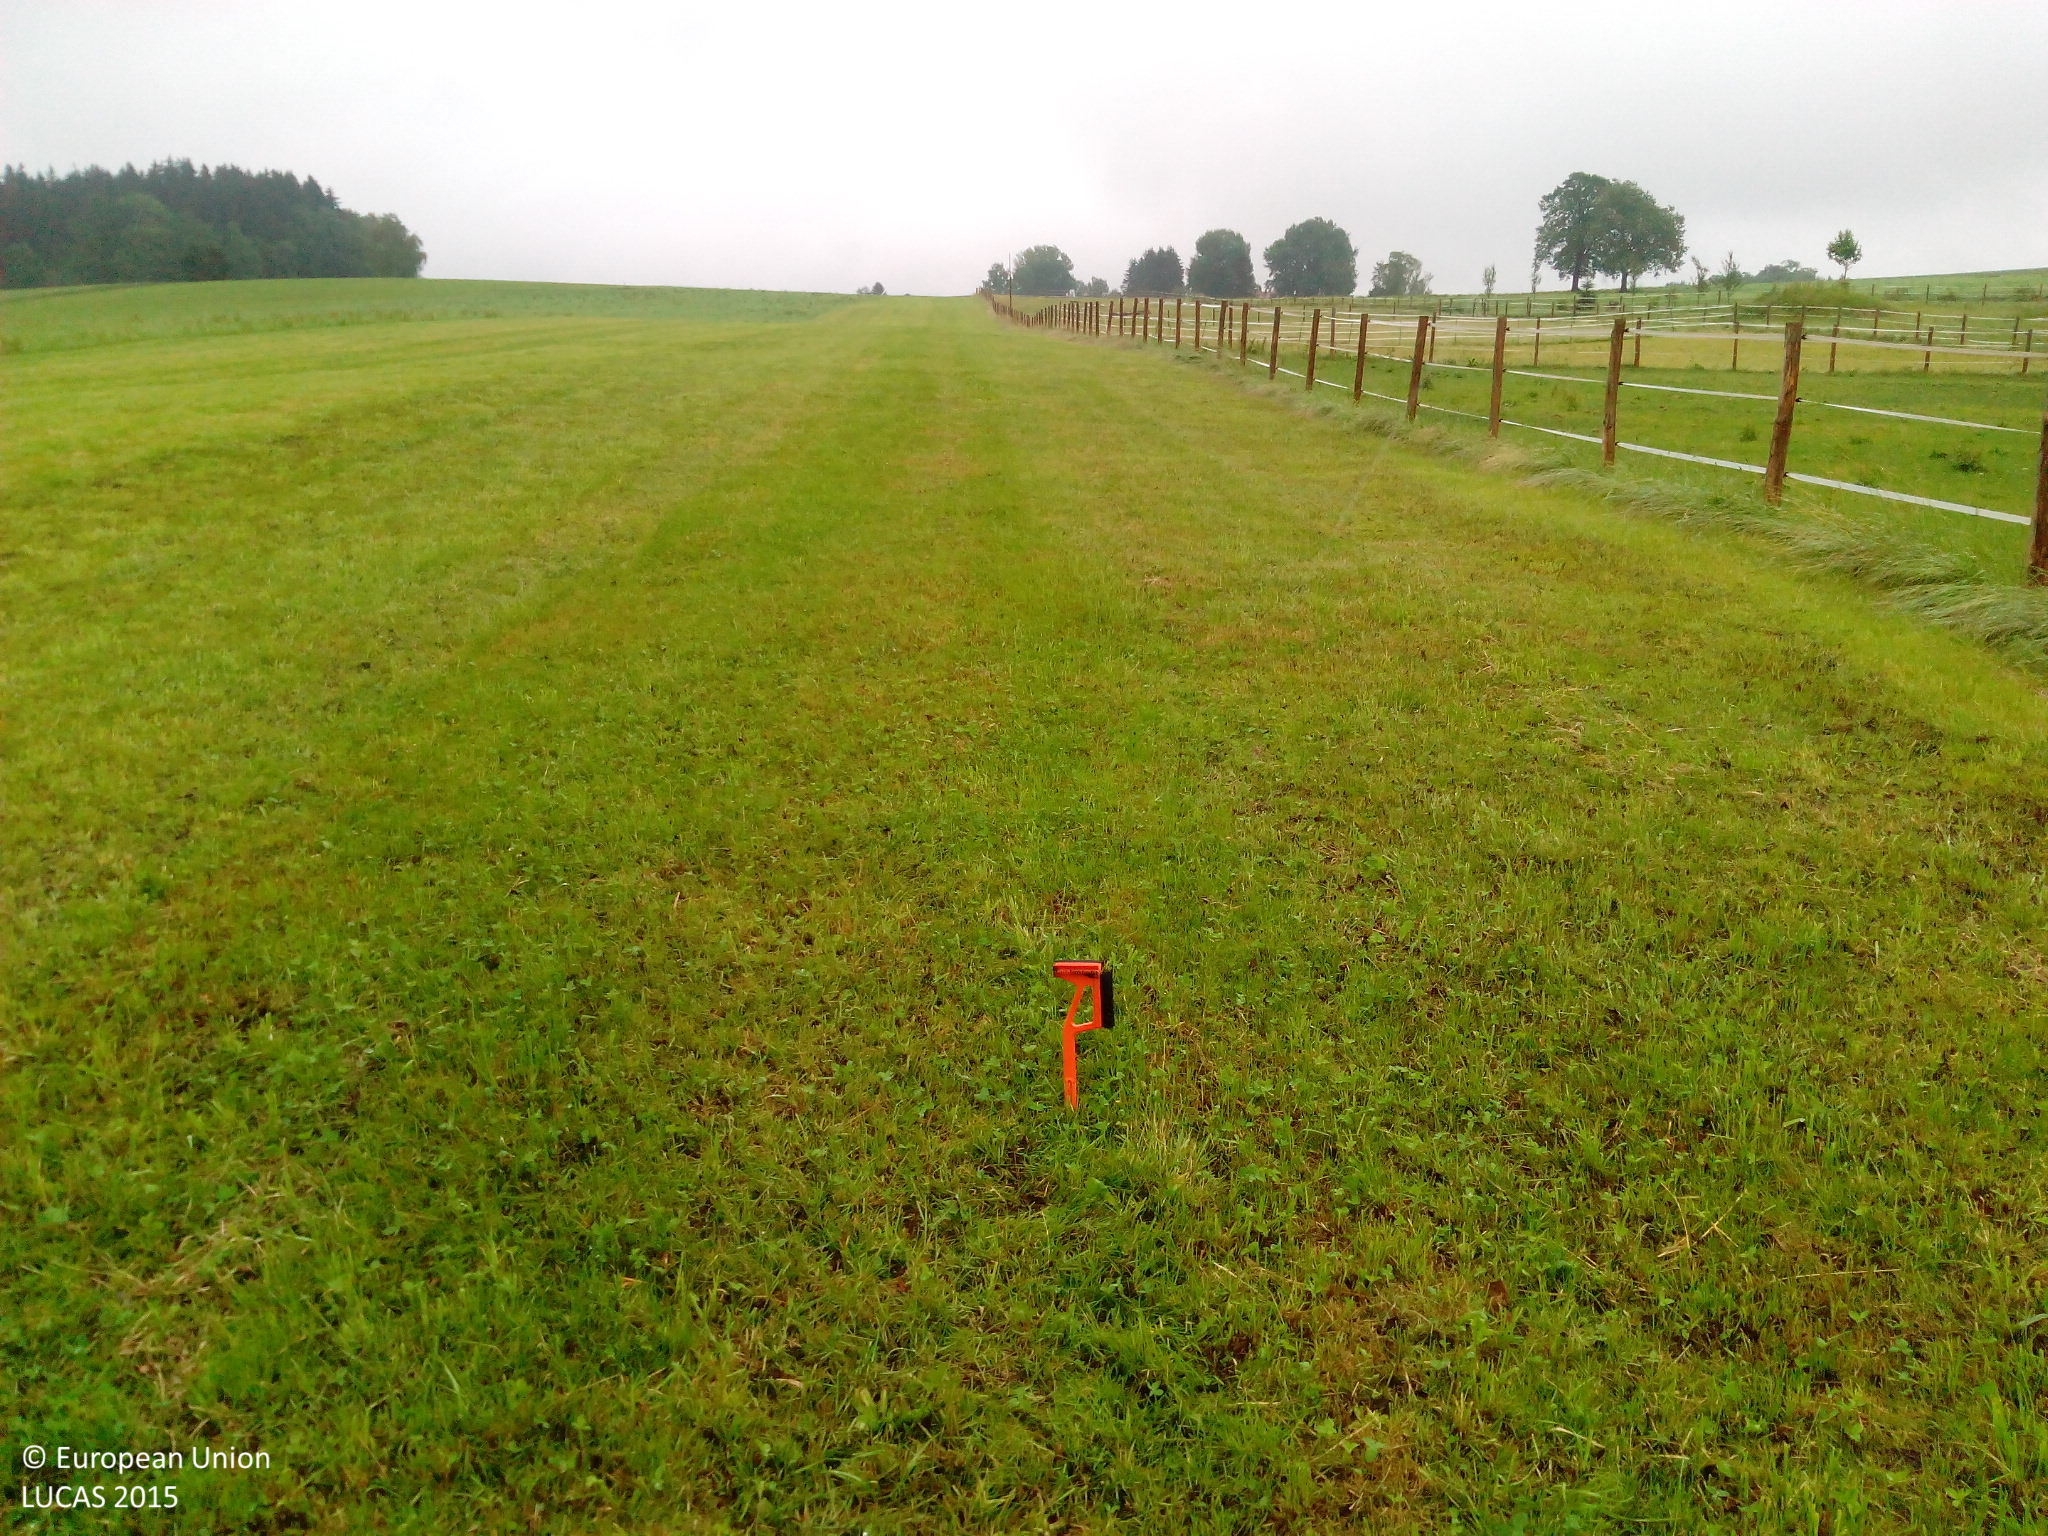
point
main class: Grassland
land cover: Grassland without tree/shrub cover
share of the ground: > 75 %
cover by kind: herbaceous plants 100 %
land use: Agriculture (excluding fallow land and kitchen gardens)
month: June
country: DE
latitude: 47.6655
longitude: 9.8536
